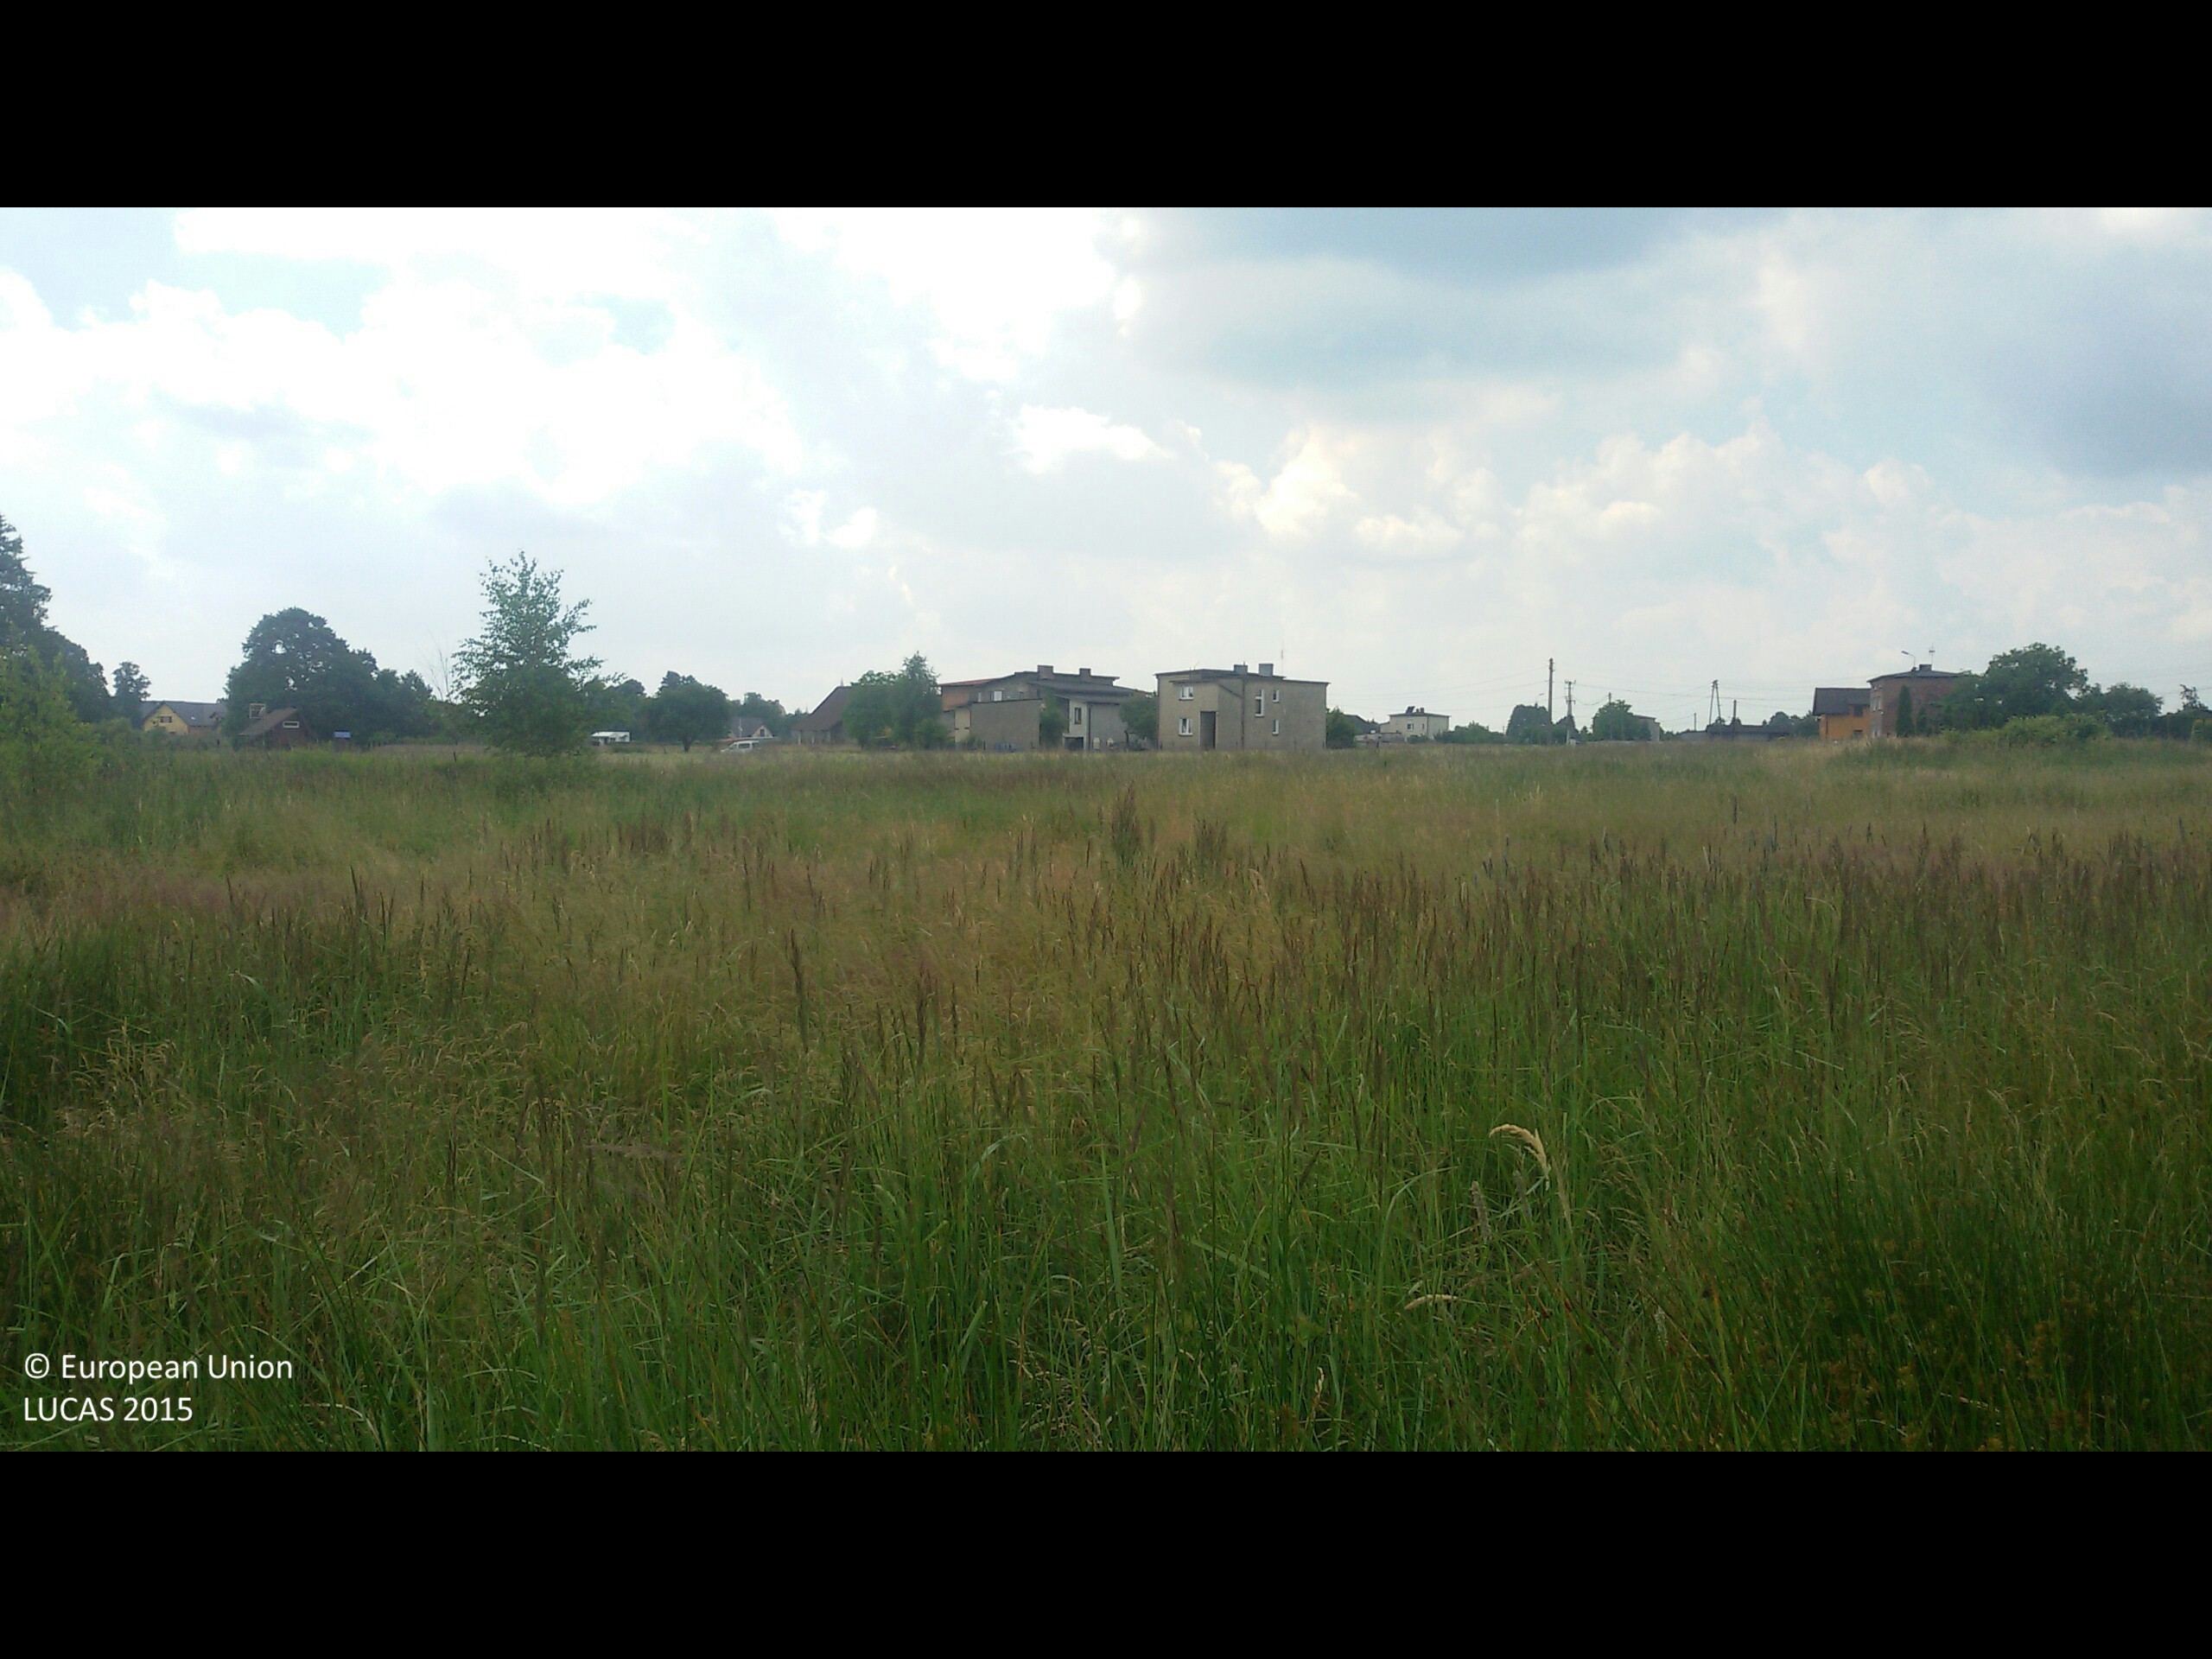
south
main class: Grassland
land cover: Grassland without tree/shrub cover
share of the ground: > 75 %
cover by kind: herbaceous plants 100 %
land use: Agriculture (excluding fallow land and kitchen gardens)
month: July
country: PL
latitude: 50.1662
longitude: 18.6015
